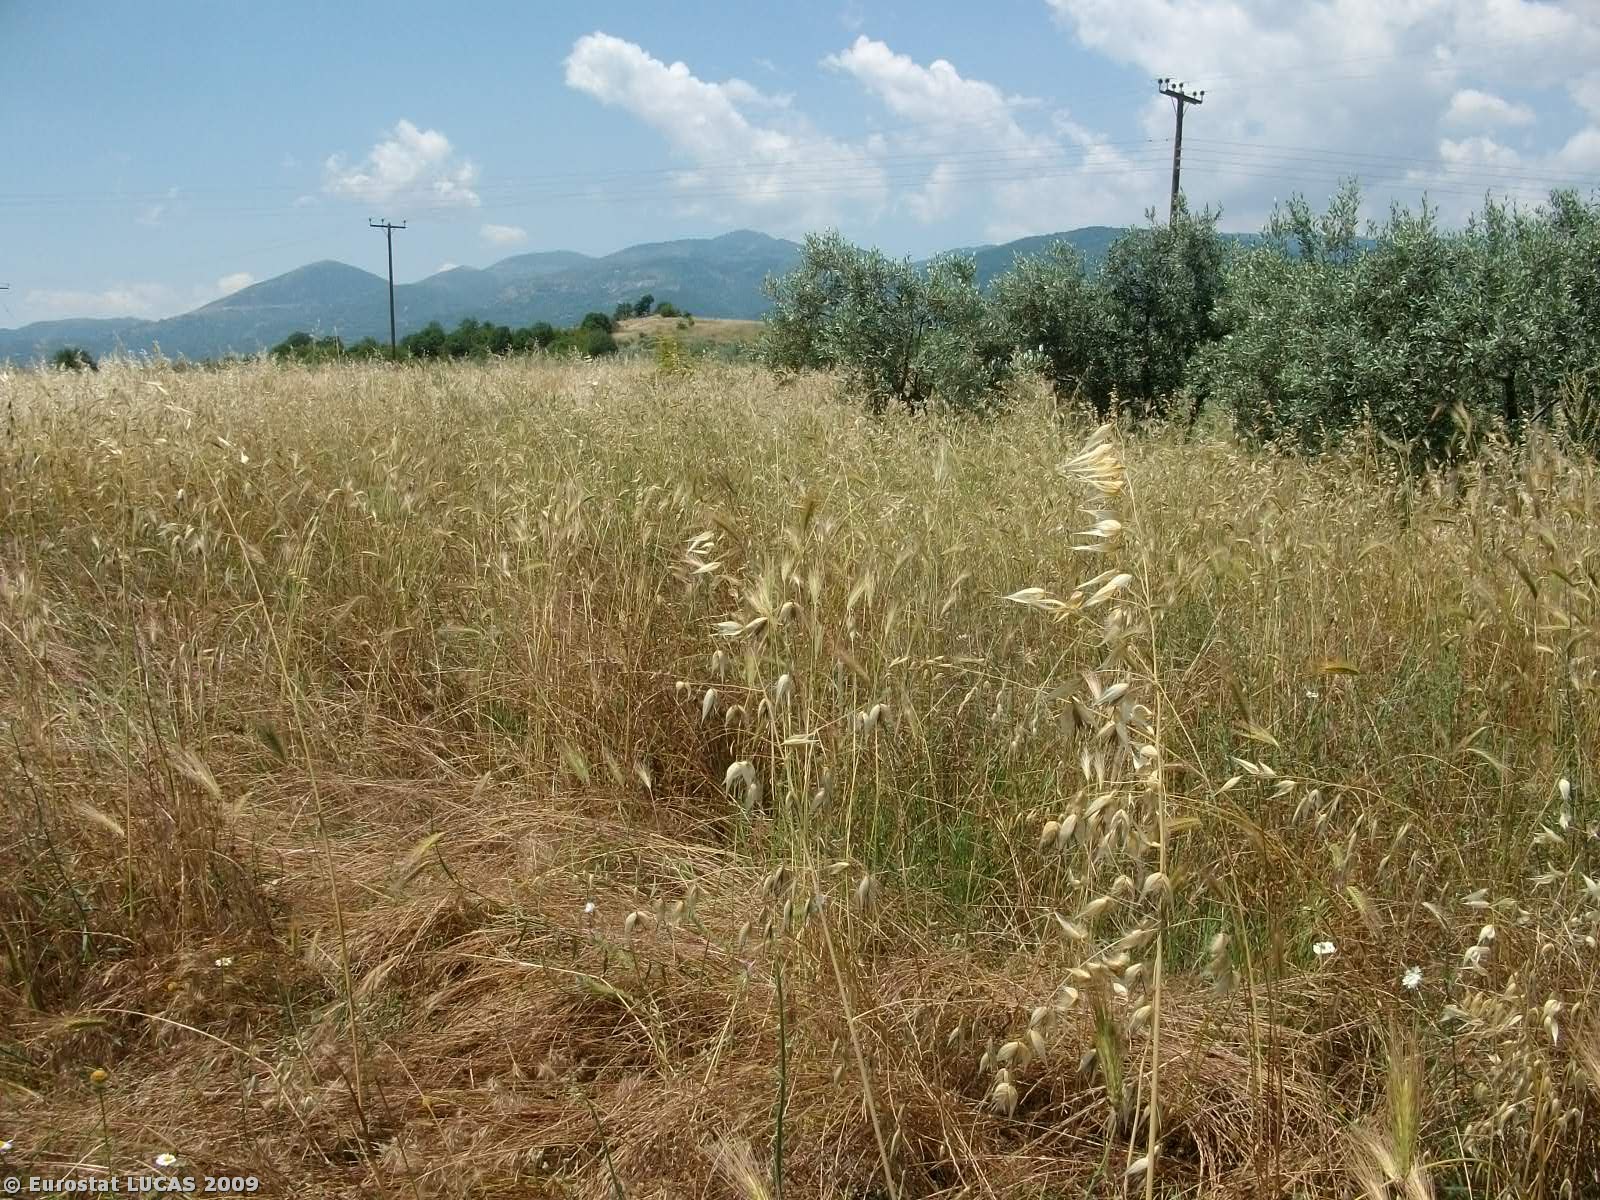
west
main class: Grassland
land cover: Grassland without tree/shrub cover
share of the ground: > 75 %
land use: Agriculture (excluding fallow land and kitchen gardens)
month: June
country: GR
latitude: 39.9392
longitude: 22.6465
